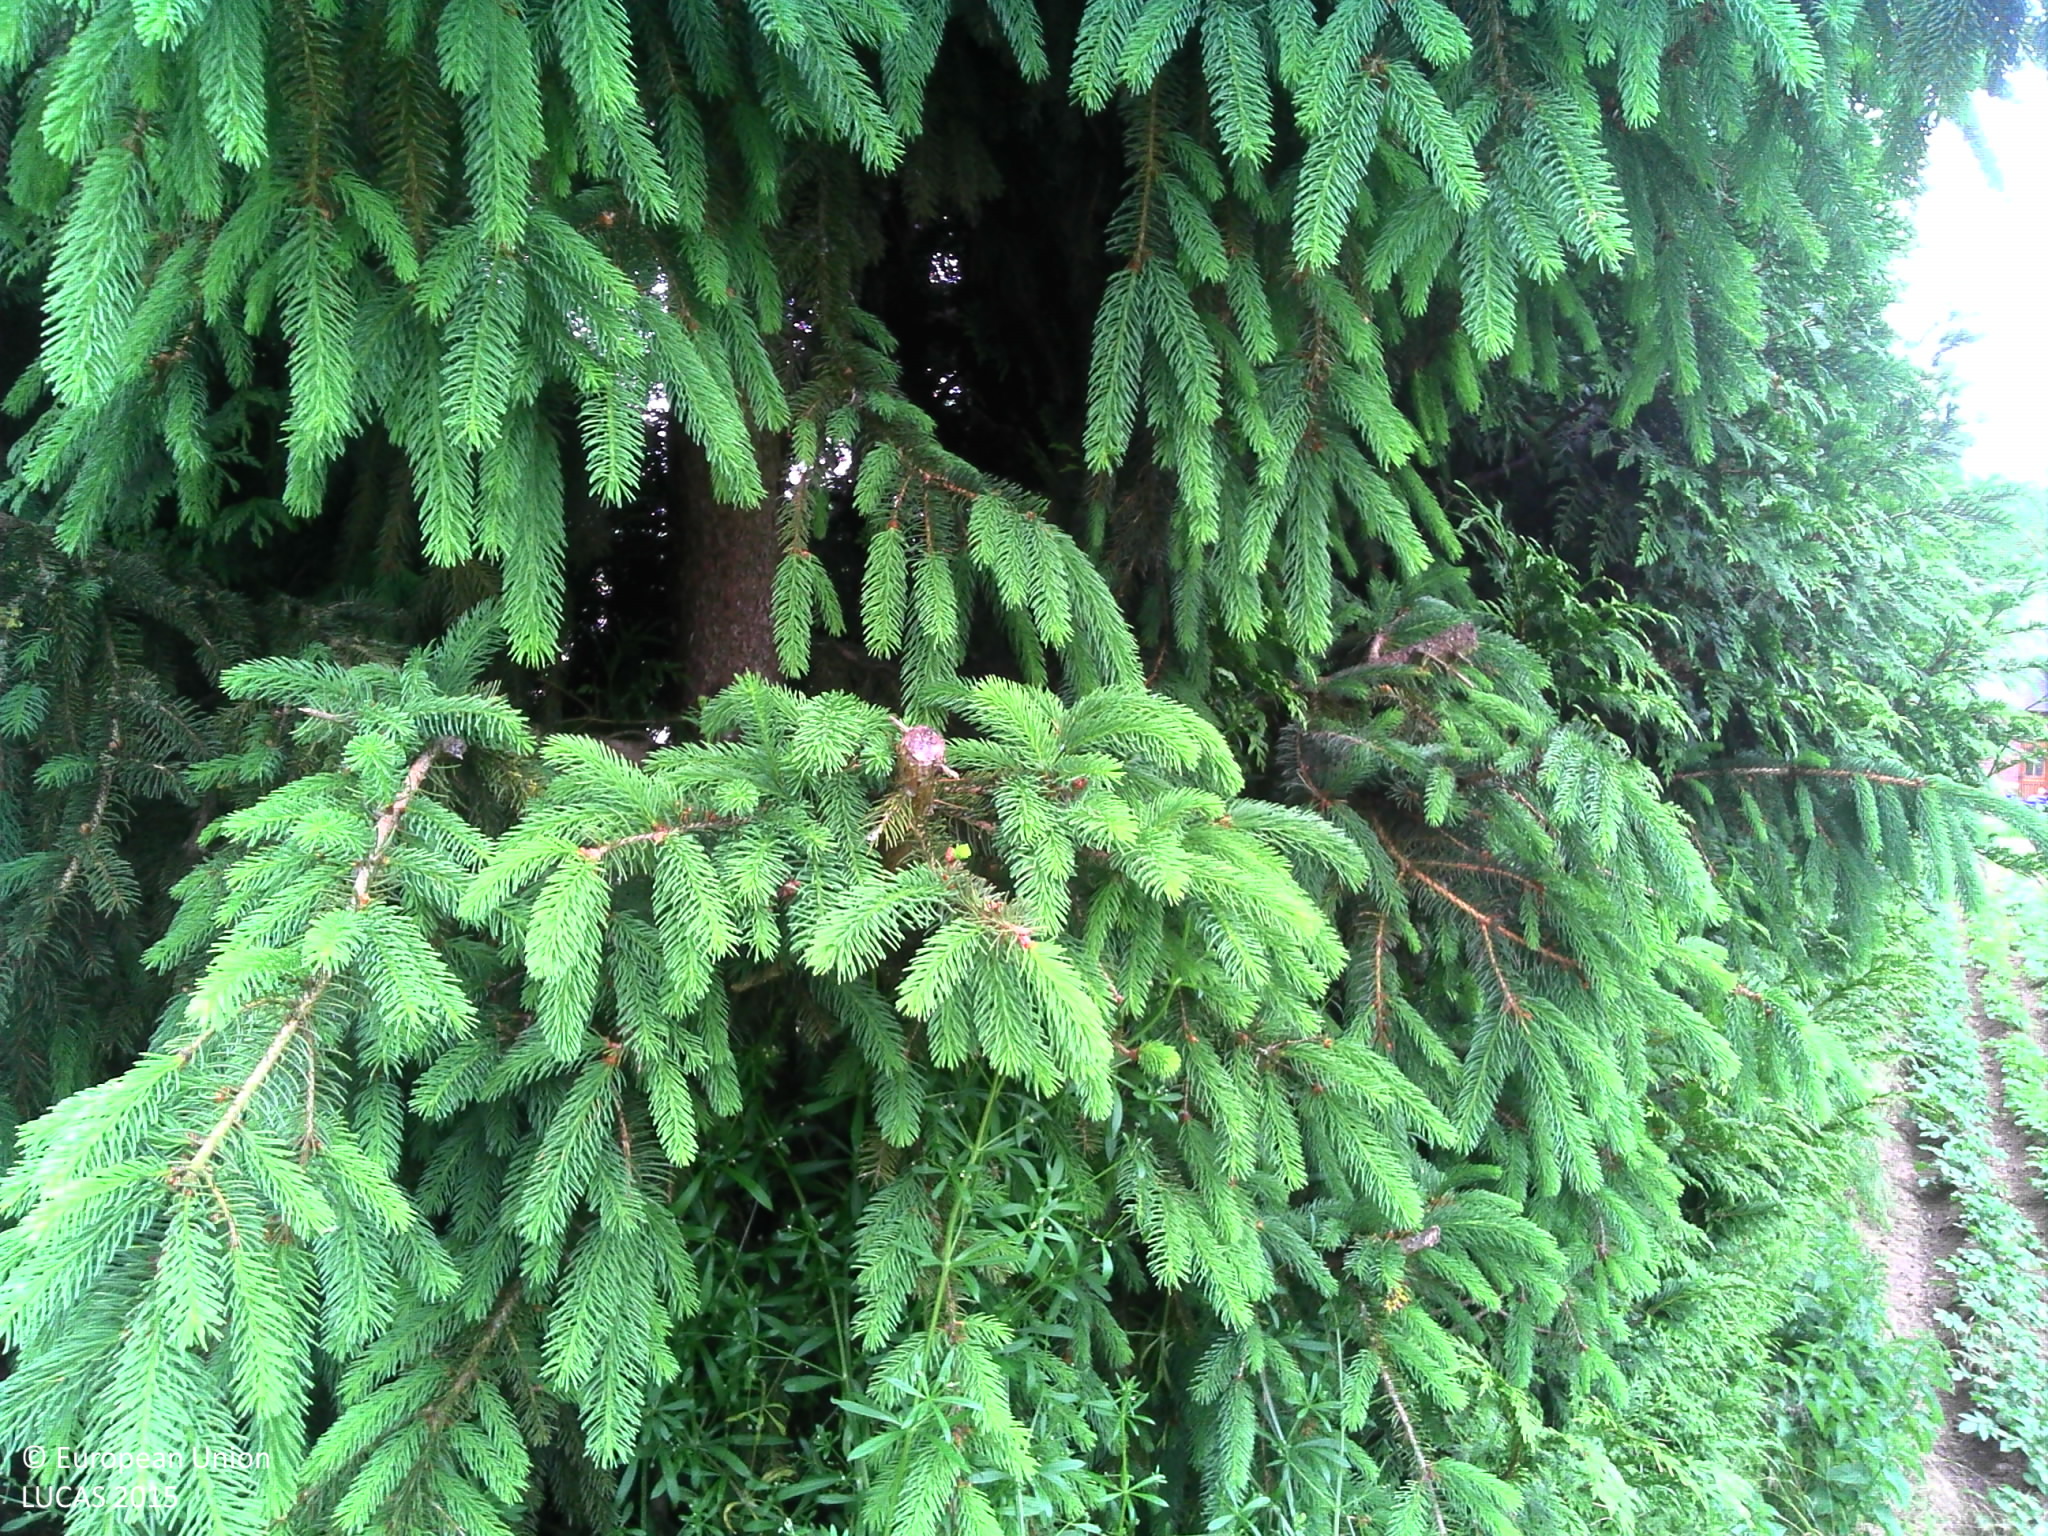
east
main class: Grassland
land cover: Grassland without tree/shrub cover
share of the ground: > 75 %
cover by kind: herbaceous plants 100 %
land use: Semi-natural and natural areas not in use
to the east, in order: Grassland without tree/shrub cover; Artificial constructions in urban areas
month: June
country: FR
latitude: 49.5158
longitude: 3.2651
